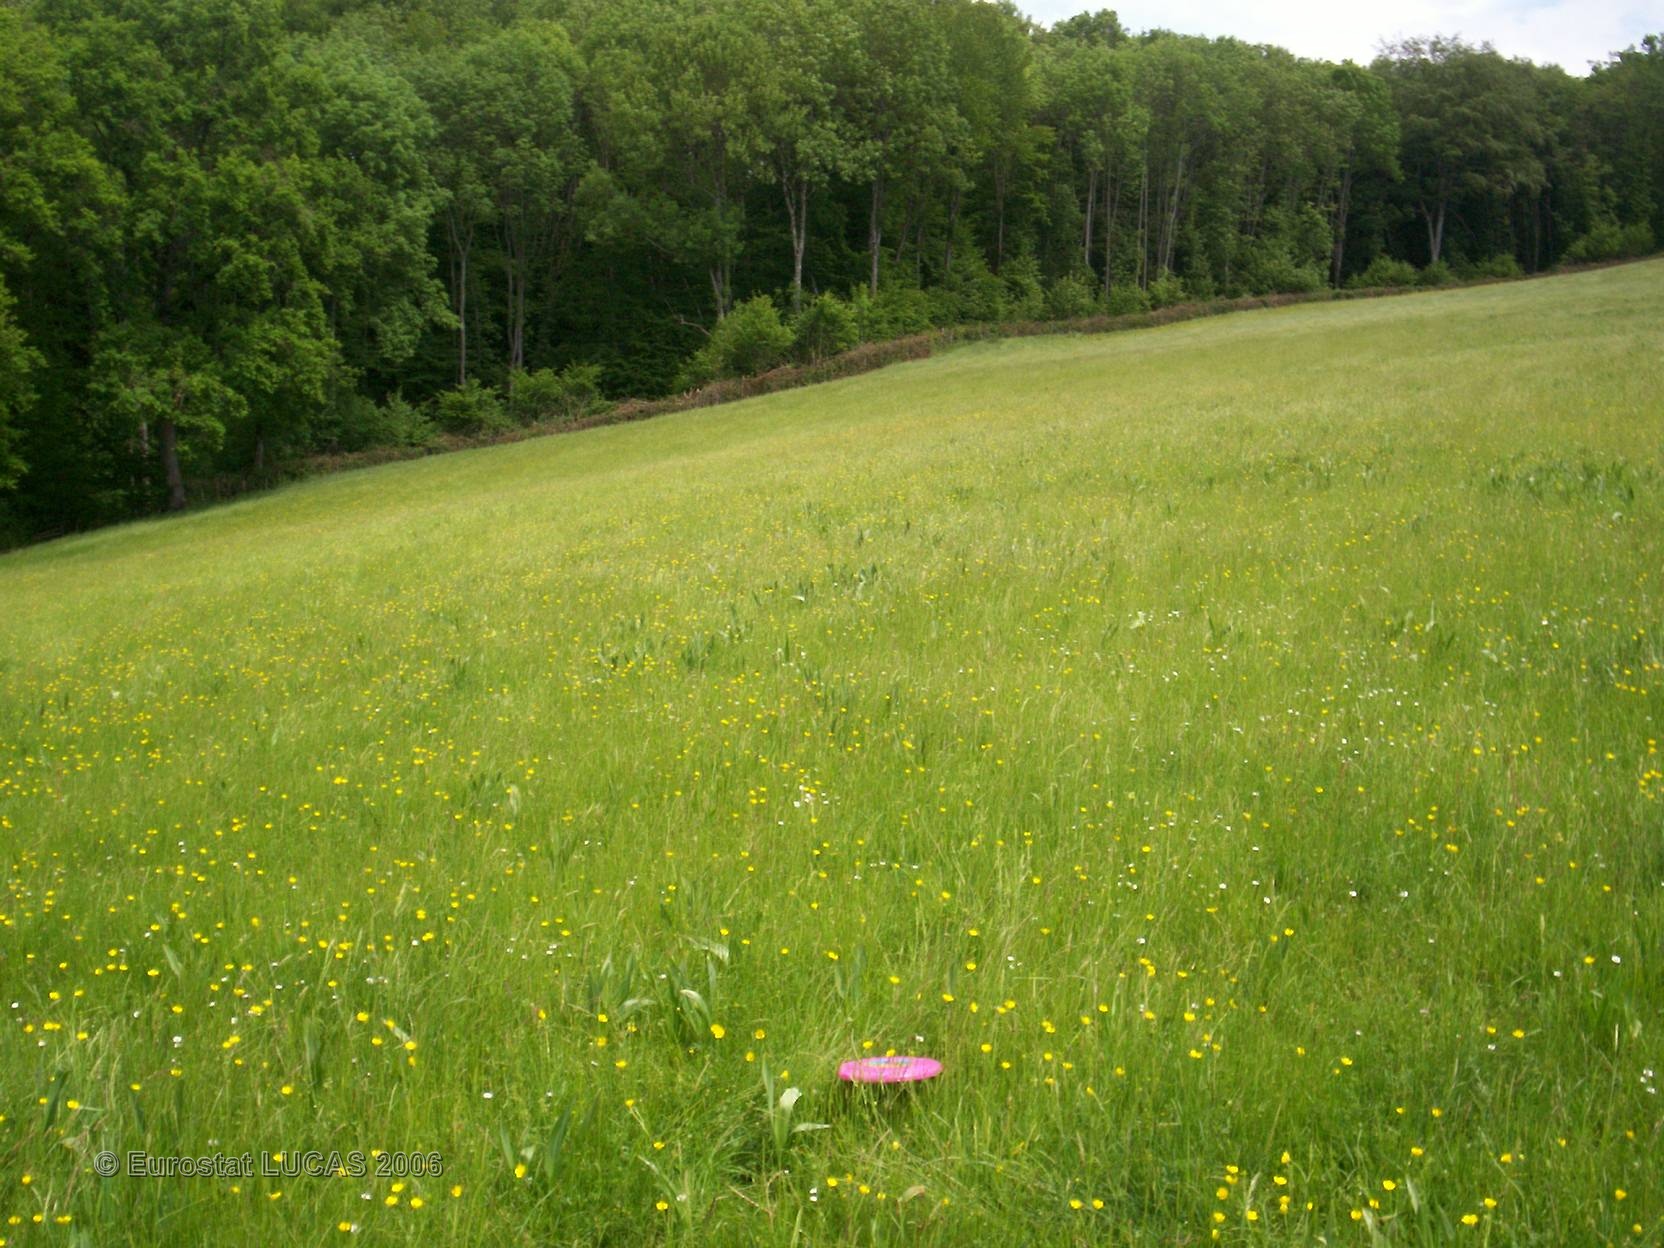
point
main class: Grassland
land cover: Grassland without tree/shrub cover
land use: Agriculture (excluding fallow land and kitchen gardens)
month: May
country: FR
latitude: 47.0445
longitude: 4.5907
